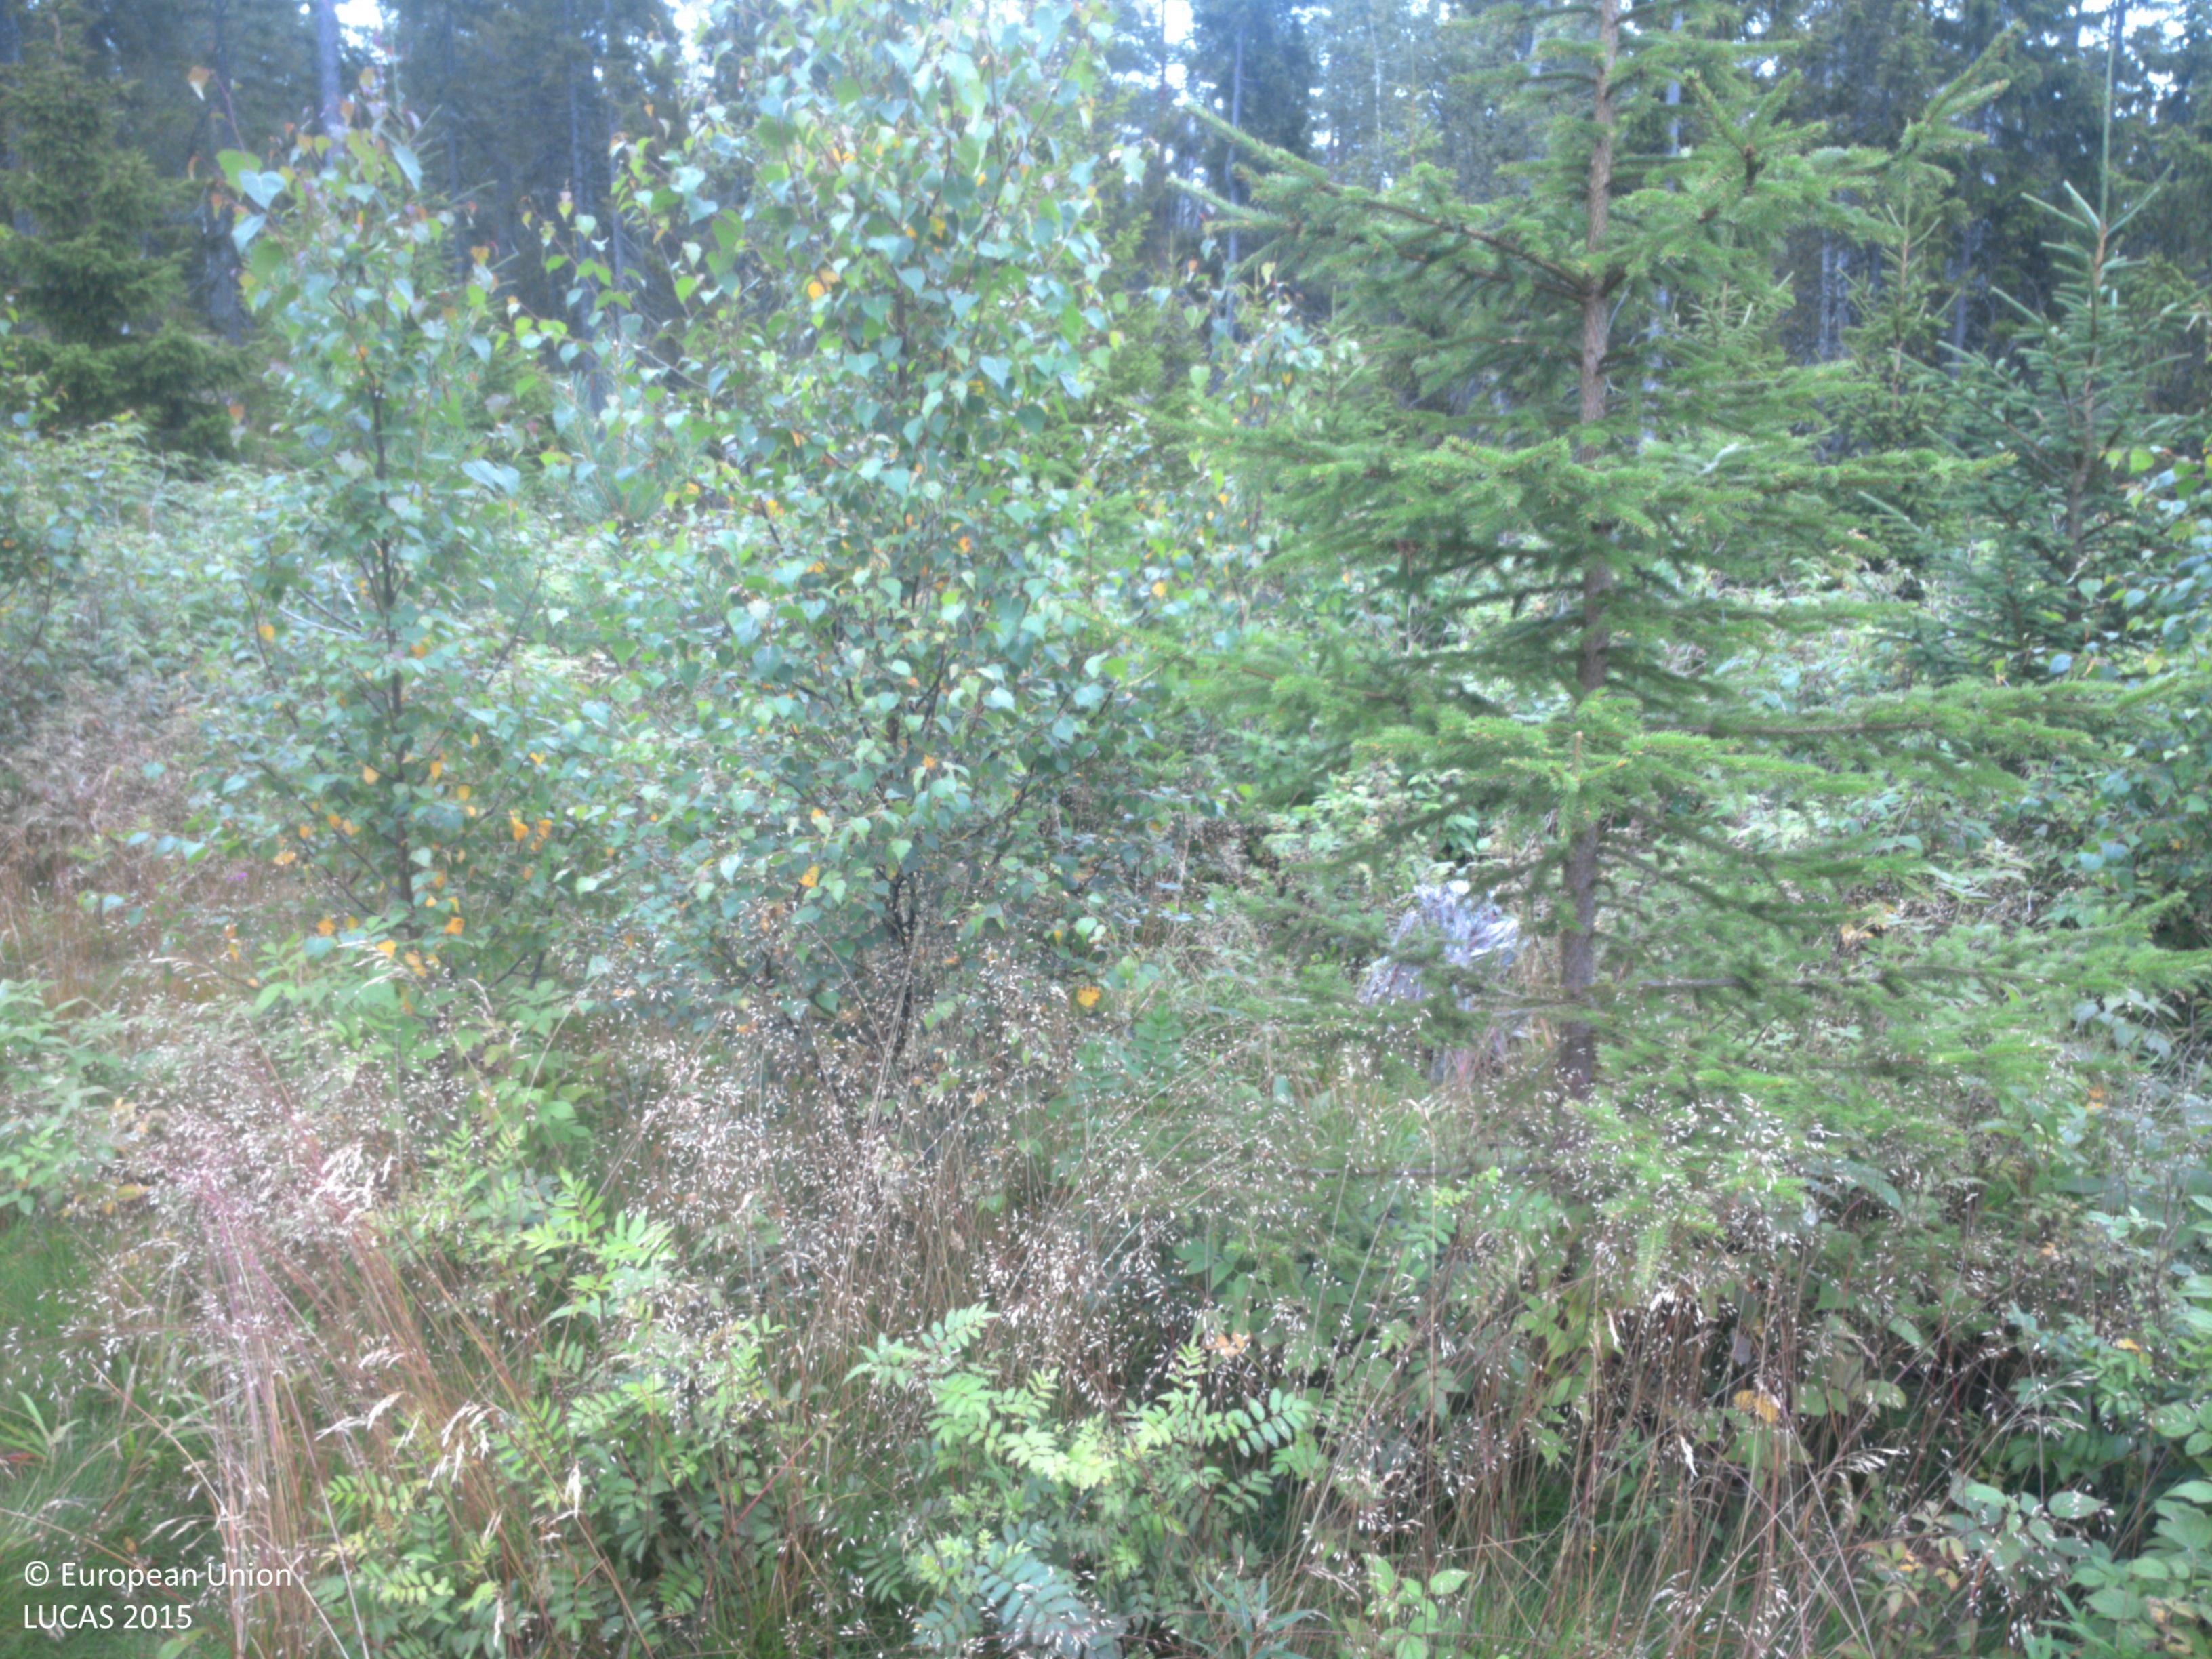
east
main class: Woodland
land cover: Pine dominated mixed woodland
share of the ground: 25 - 50 %
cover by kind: shrubs 60 %, coniferous forest trees 20 %, broadleaved forest trees 10 %, lichens and mosses 10 %
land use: Forestry
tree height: < 5 m
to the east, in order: Pine dominated mixed woodland; Spruce dominated coniferous woodland; Other coniferous woodland; Pine dominated coniferous woodland
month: August
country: SE
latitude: 63.7479
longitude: 19.8075
